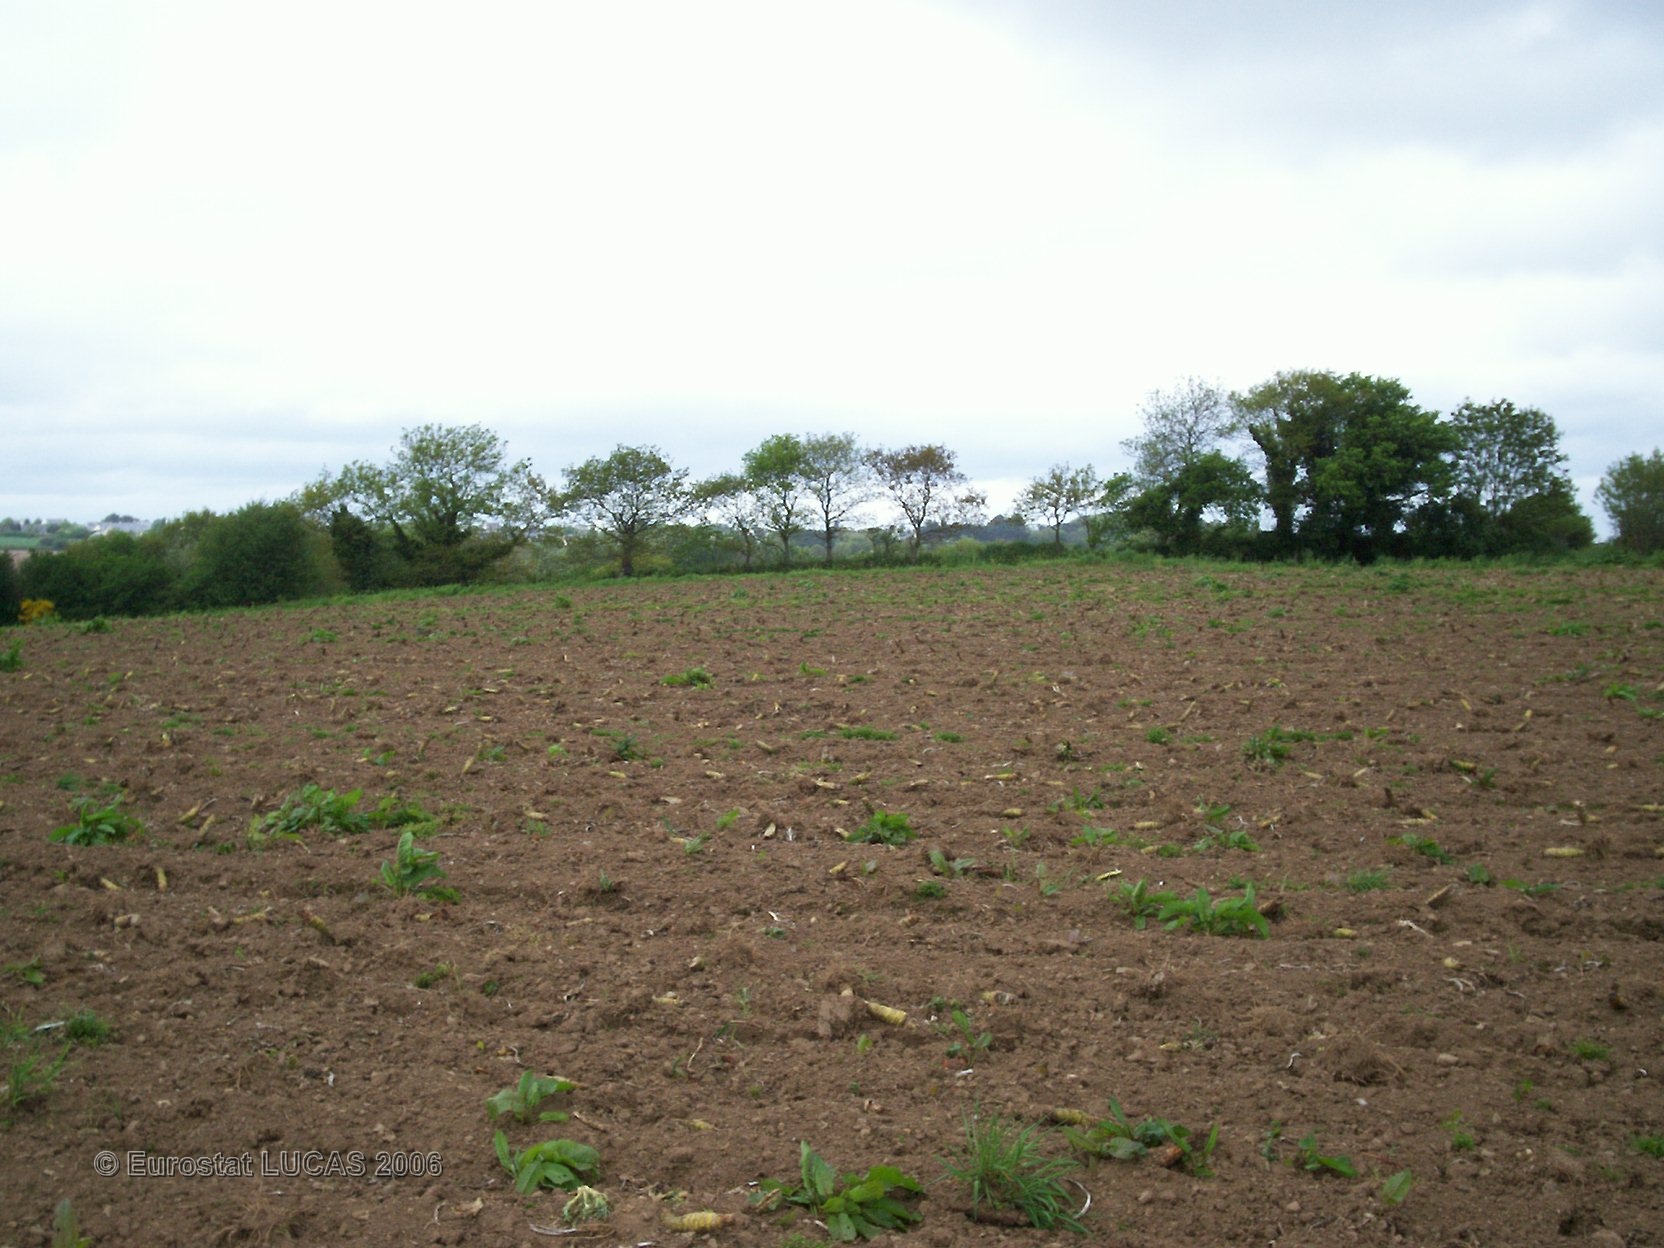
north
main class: Bare land
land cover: Bare land
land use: Agriculture (excluding fallow land and kitchen gardens)
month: May
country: FR
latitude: 48.6588
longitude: -3.7003
